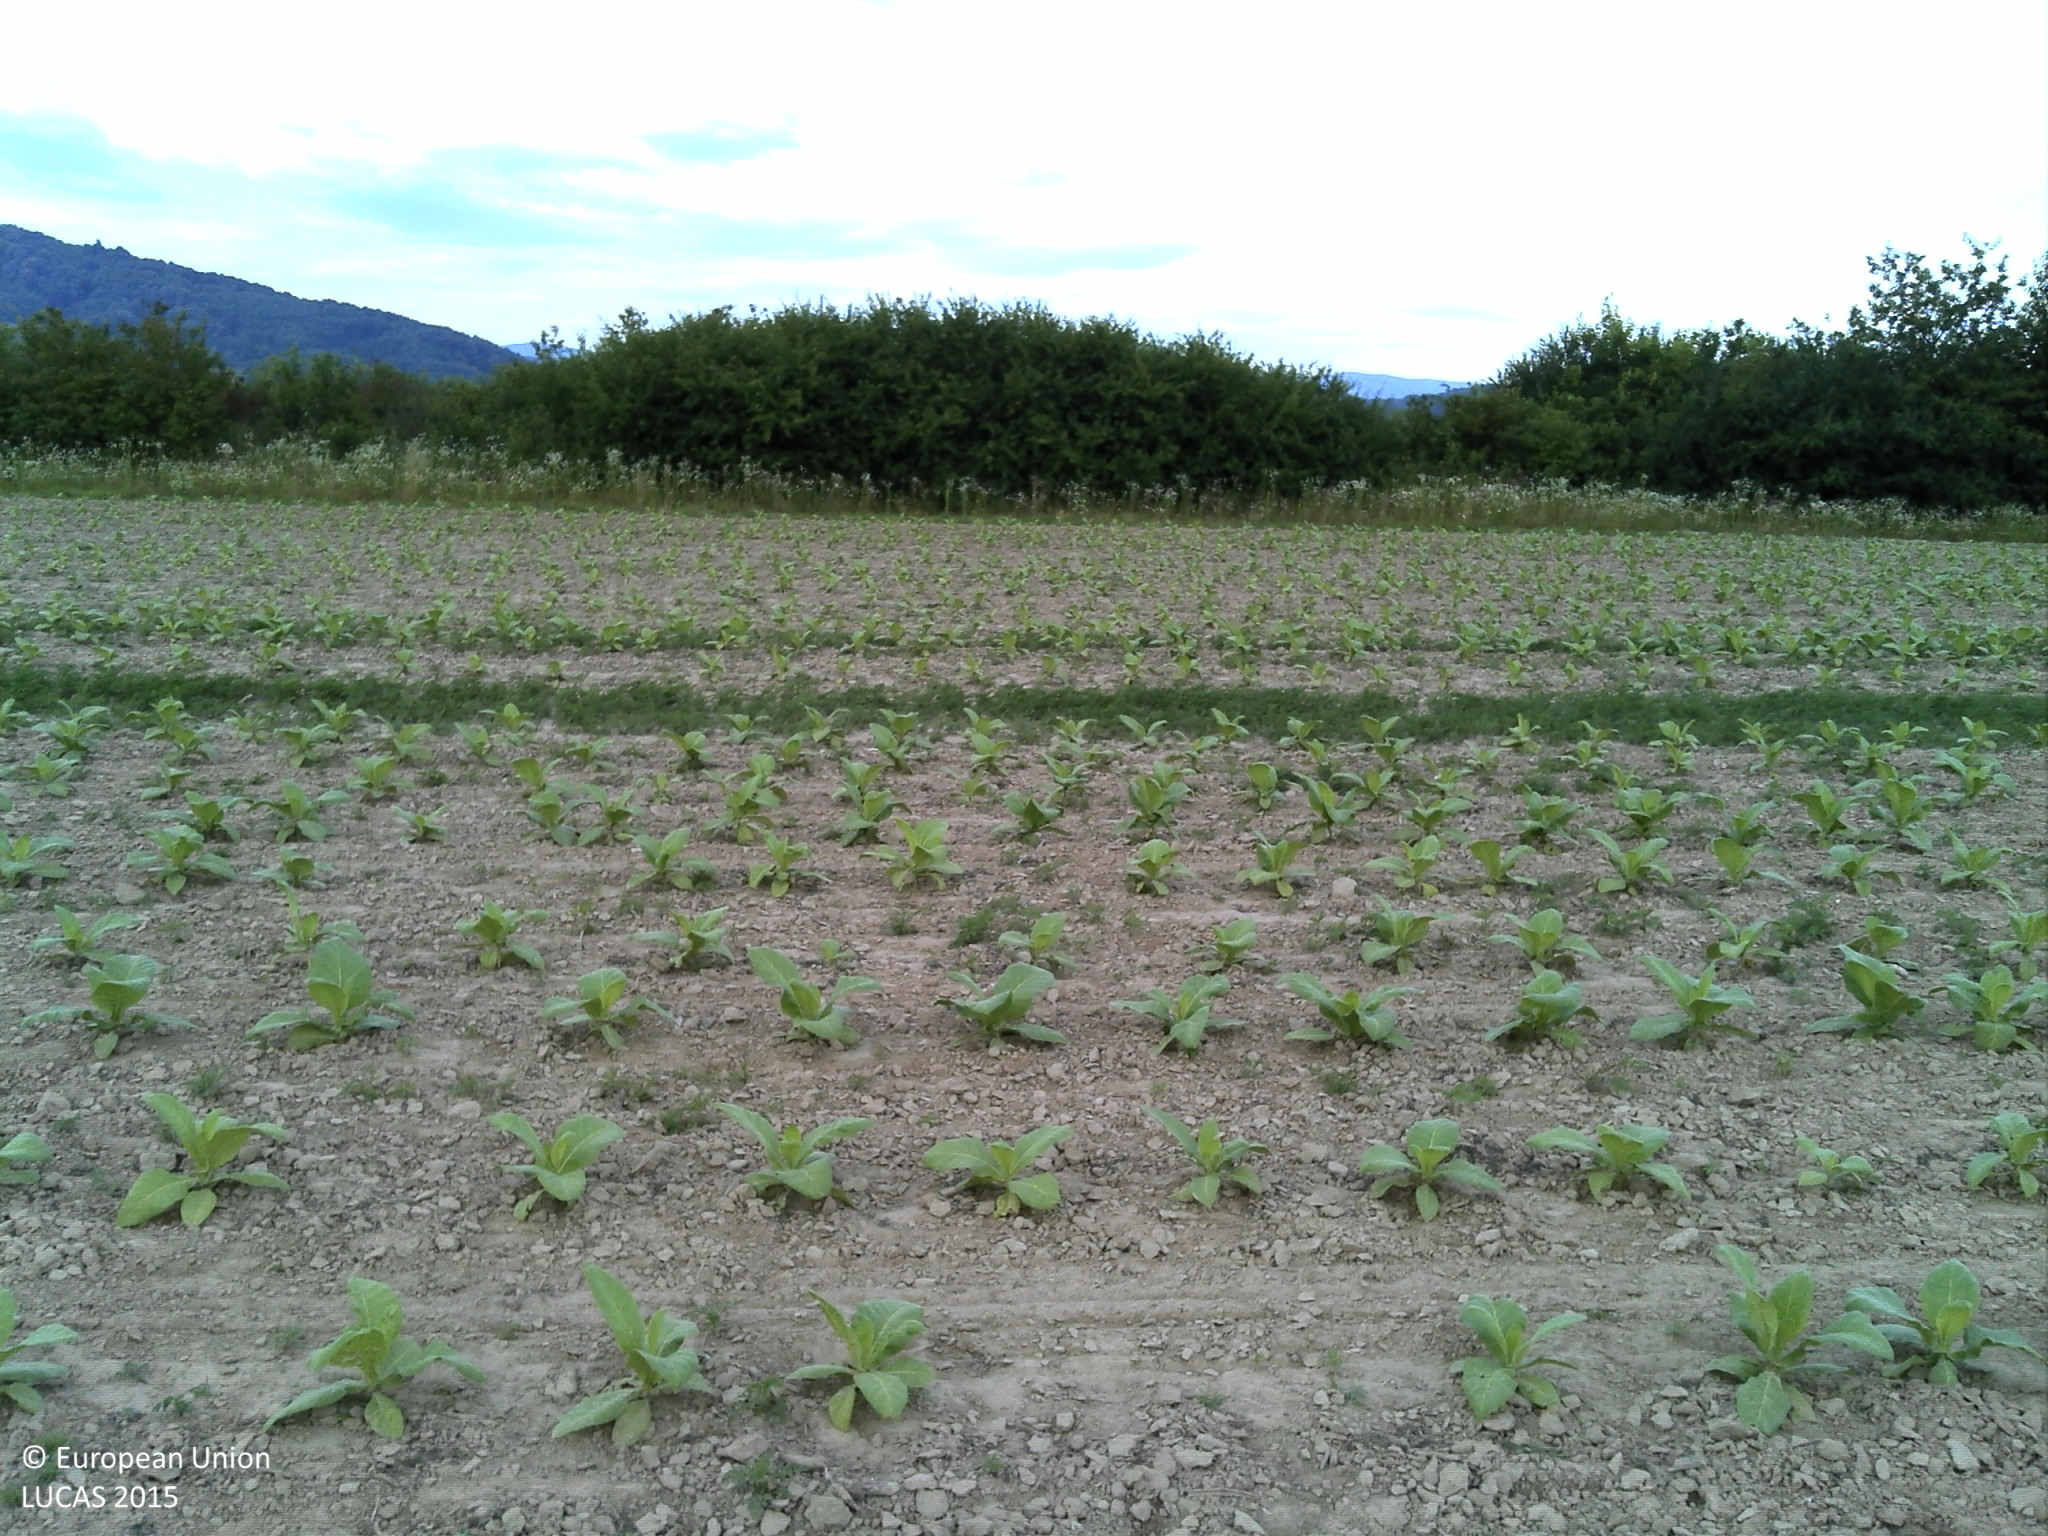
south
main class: Cropland
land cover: Sugar beet
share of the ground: < 10 %
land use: Agriculture (excluding fallow land and kitchen gardens)
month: June
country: HR
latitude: 45.7765
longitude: 17.5520
